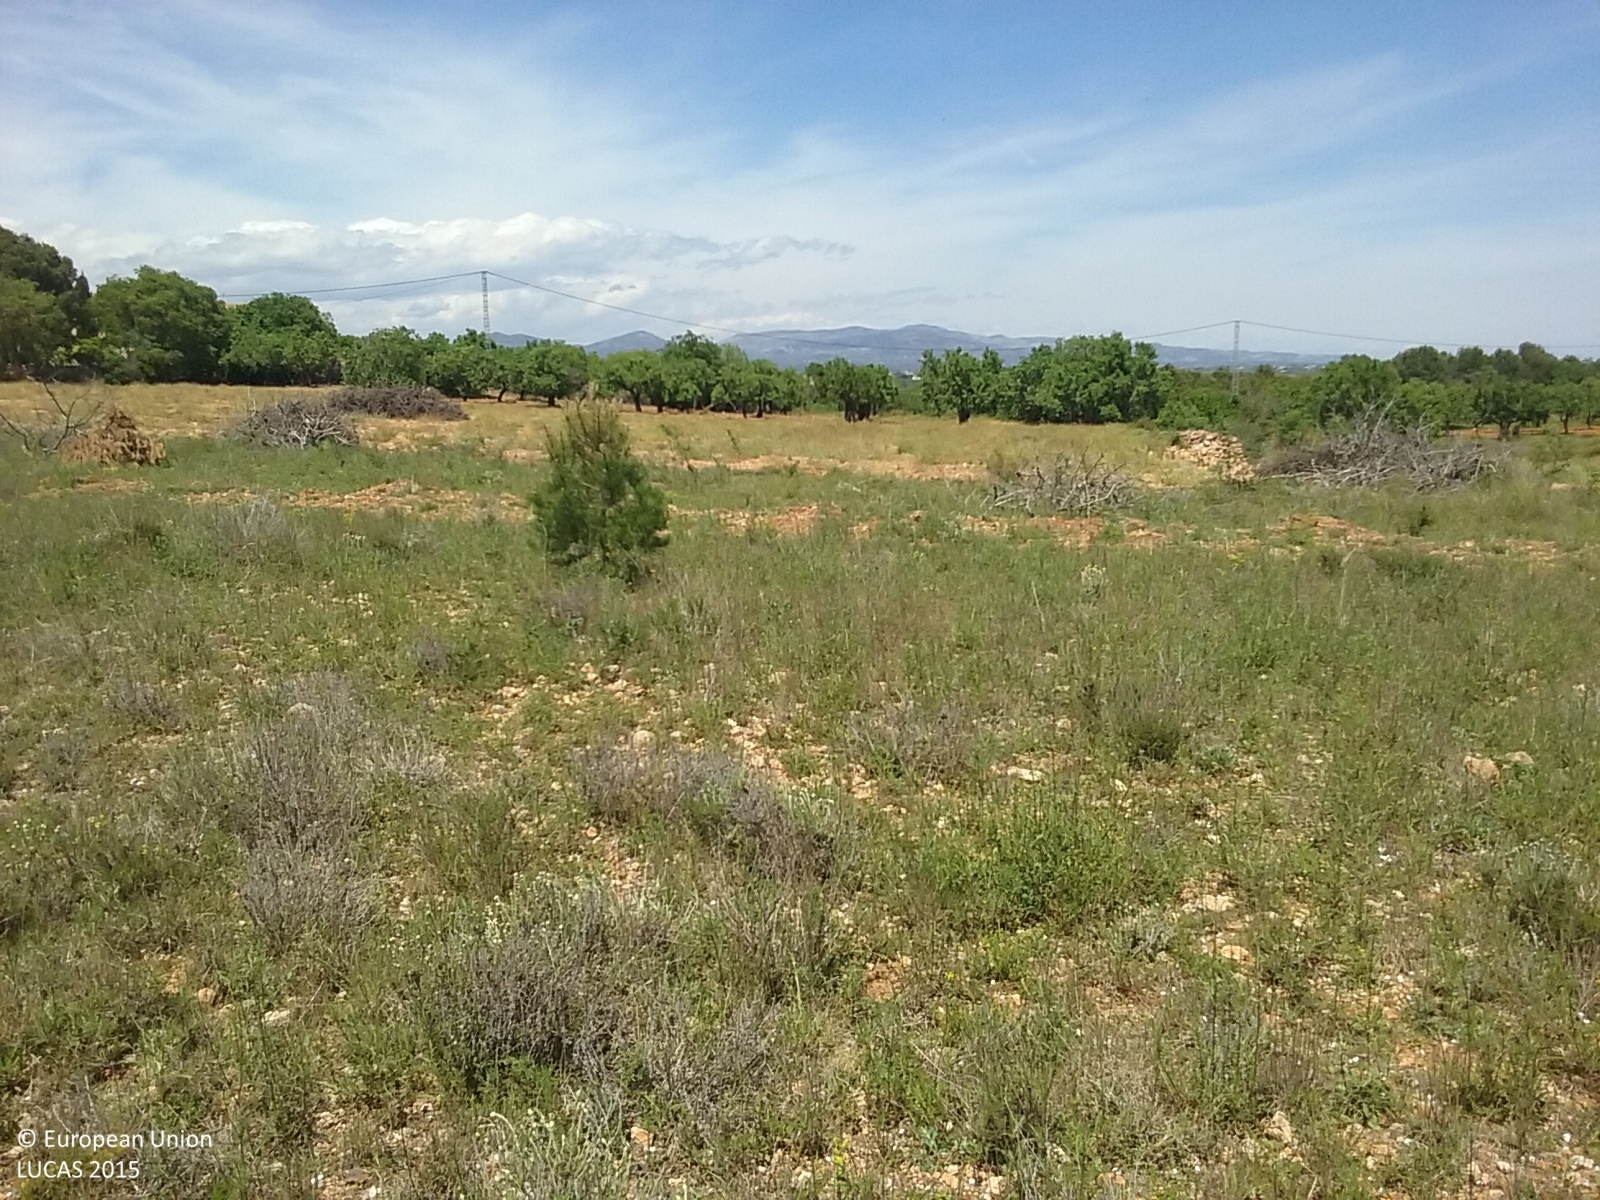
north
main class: Grassland
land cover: Spontaneously vegetated surfaces
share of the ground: > 75 %
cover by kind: herbaceous plants 95 %, shrubs 5 %
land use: Abandoned areas
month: May
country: ES
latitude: 40.1363
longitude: -0.0137
